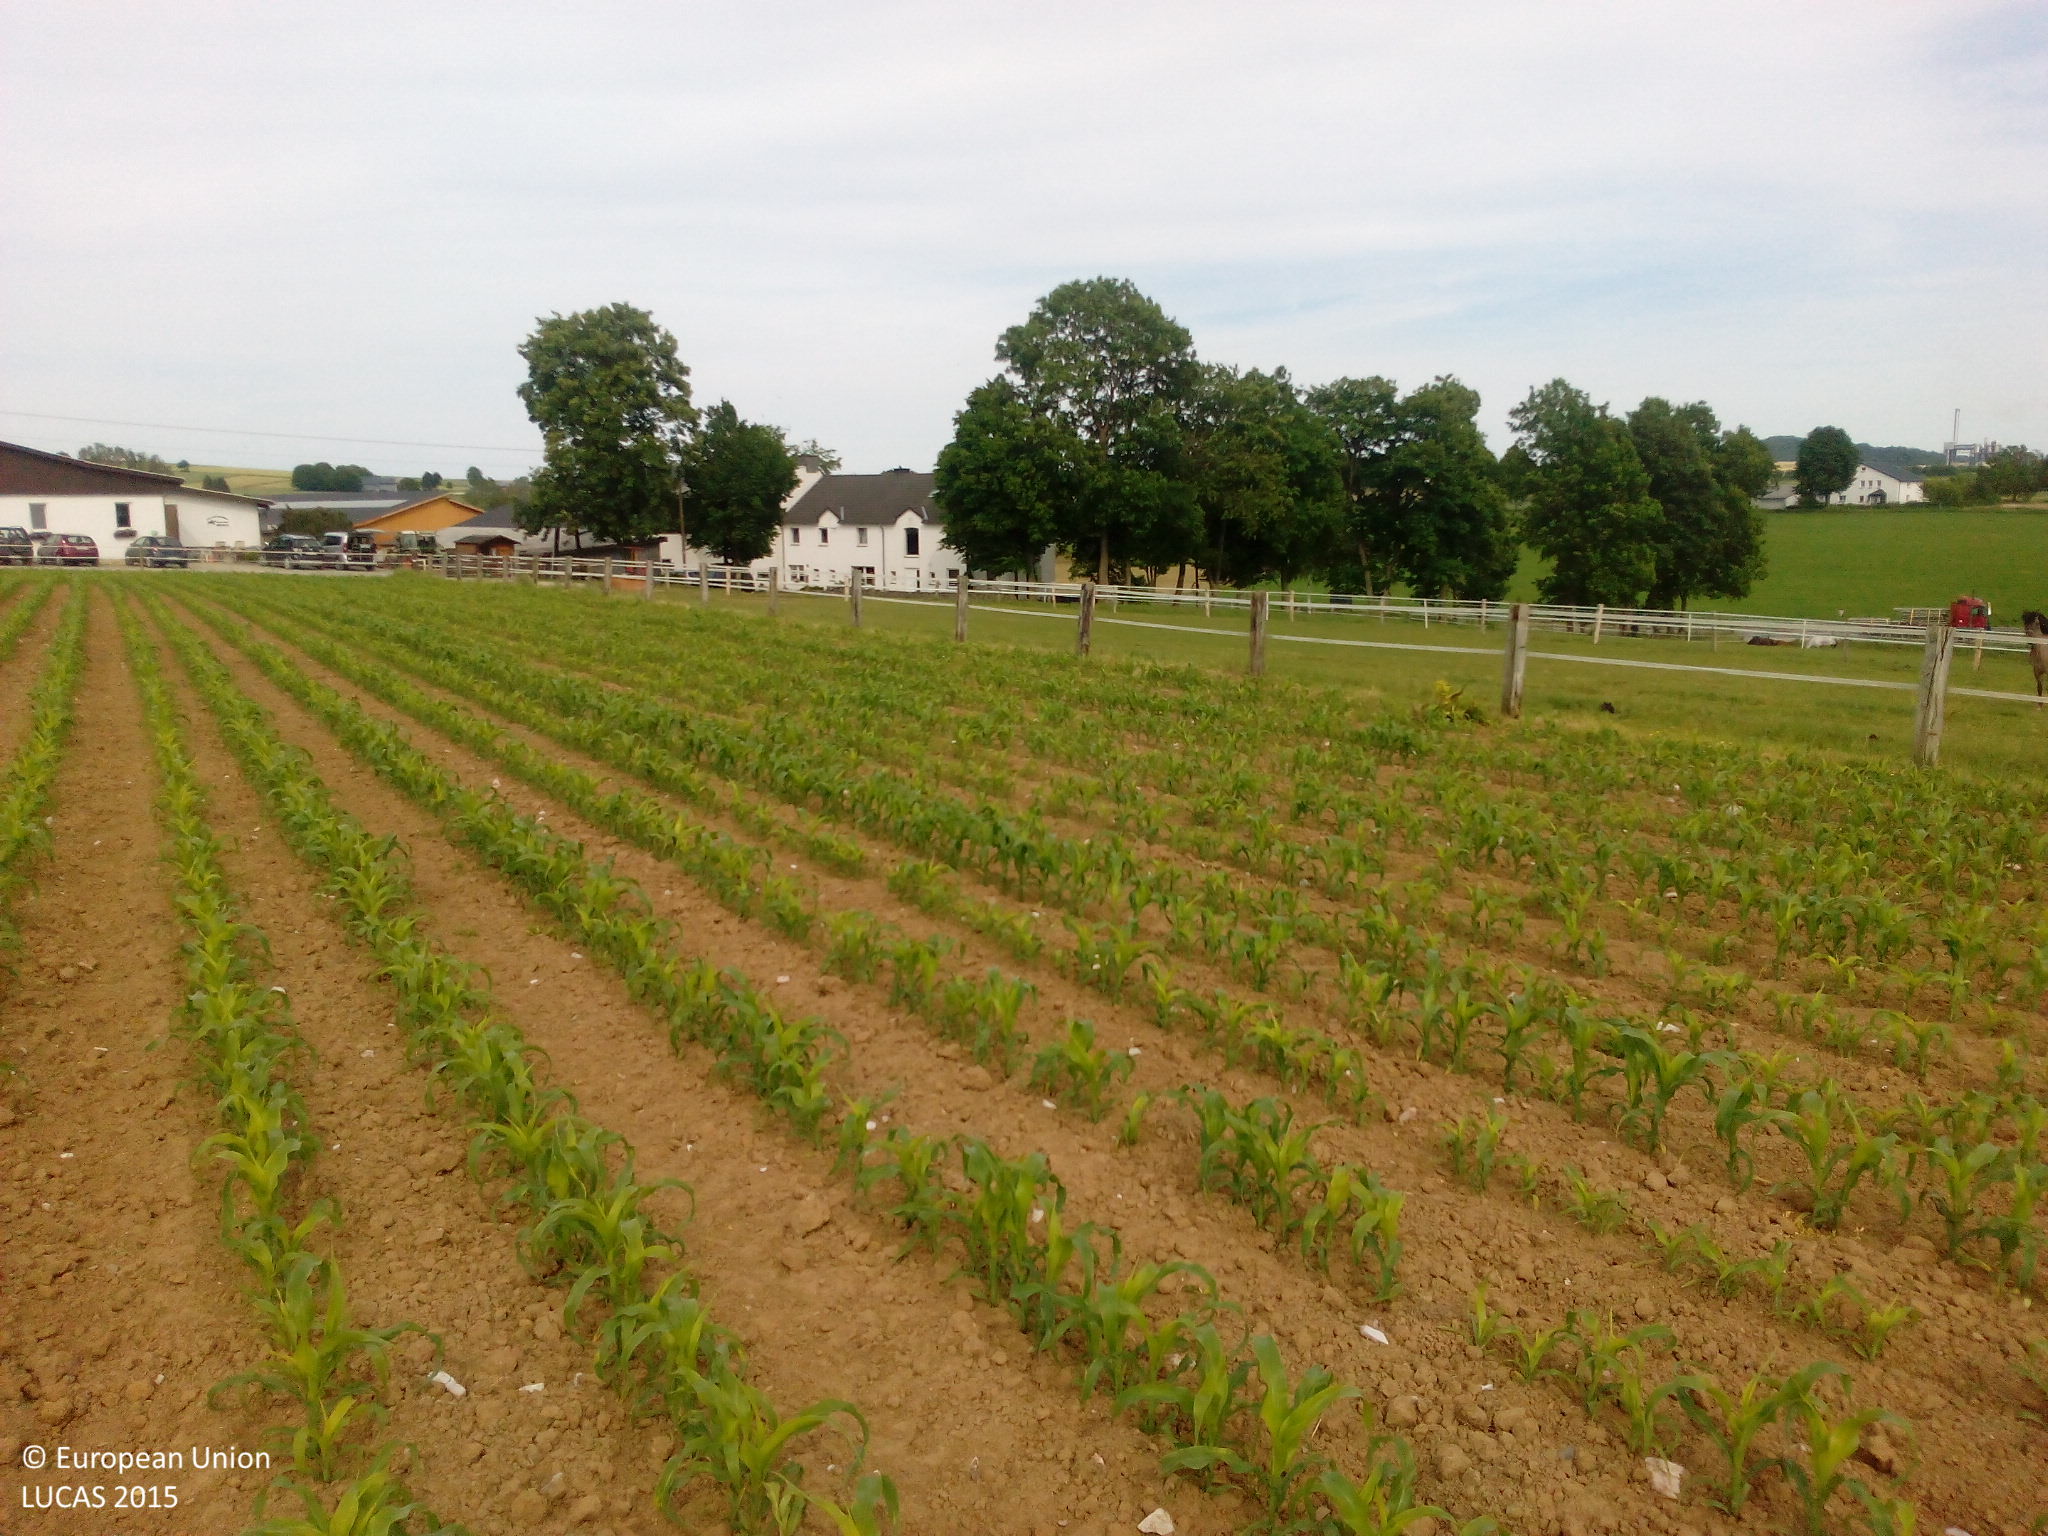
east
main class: Cropland
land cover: Maize
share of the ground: 25 - 50 %
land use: Agriculture (excluding fallow land and kitchen gardens)
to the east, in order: Maize; Fences; Grassland without tree/shrub cover; Fences; Grassland without tree/shrub cover; Artificial constructions in urban areas; Grassland without tree/shrub cover; Abandoned hedges; Fences; Grass margins; Paved roads, cycling and walking lanes; Grassland without tree/shrub cover; Broadleaved woodland; Shrubland without tree cover; Rivers and streams; Grassland without tree/shrub cover
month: June
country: DE
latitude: 51.4161
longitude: 8.5768
